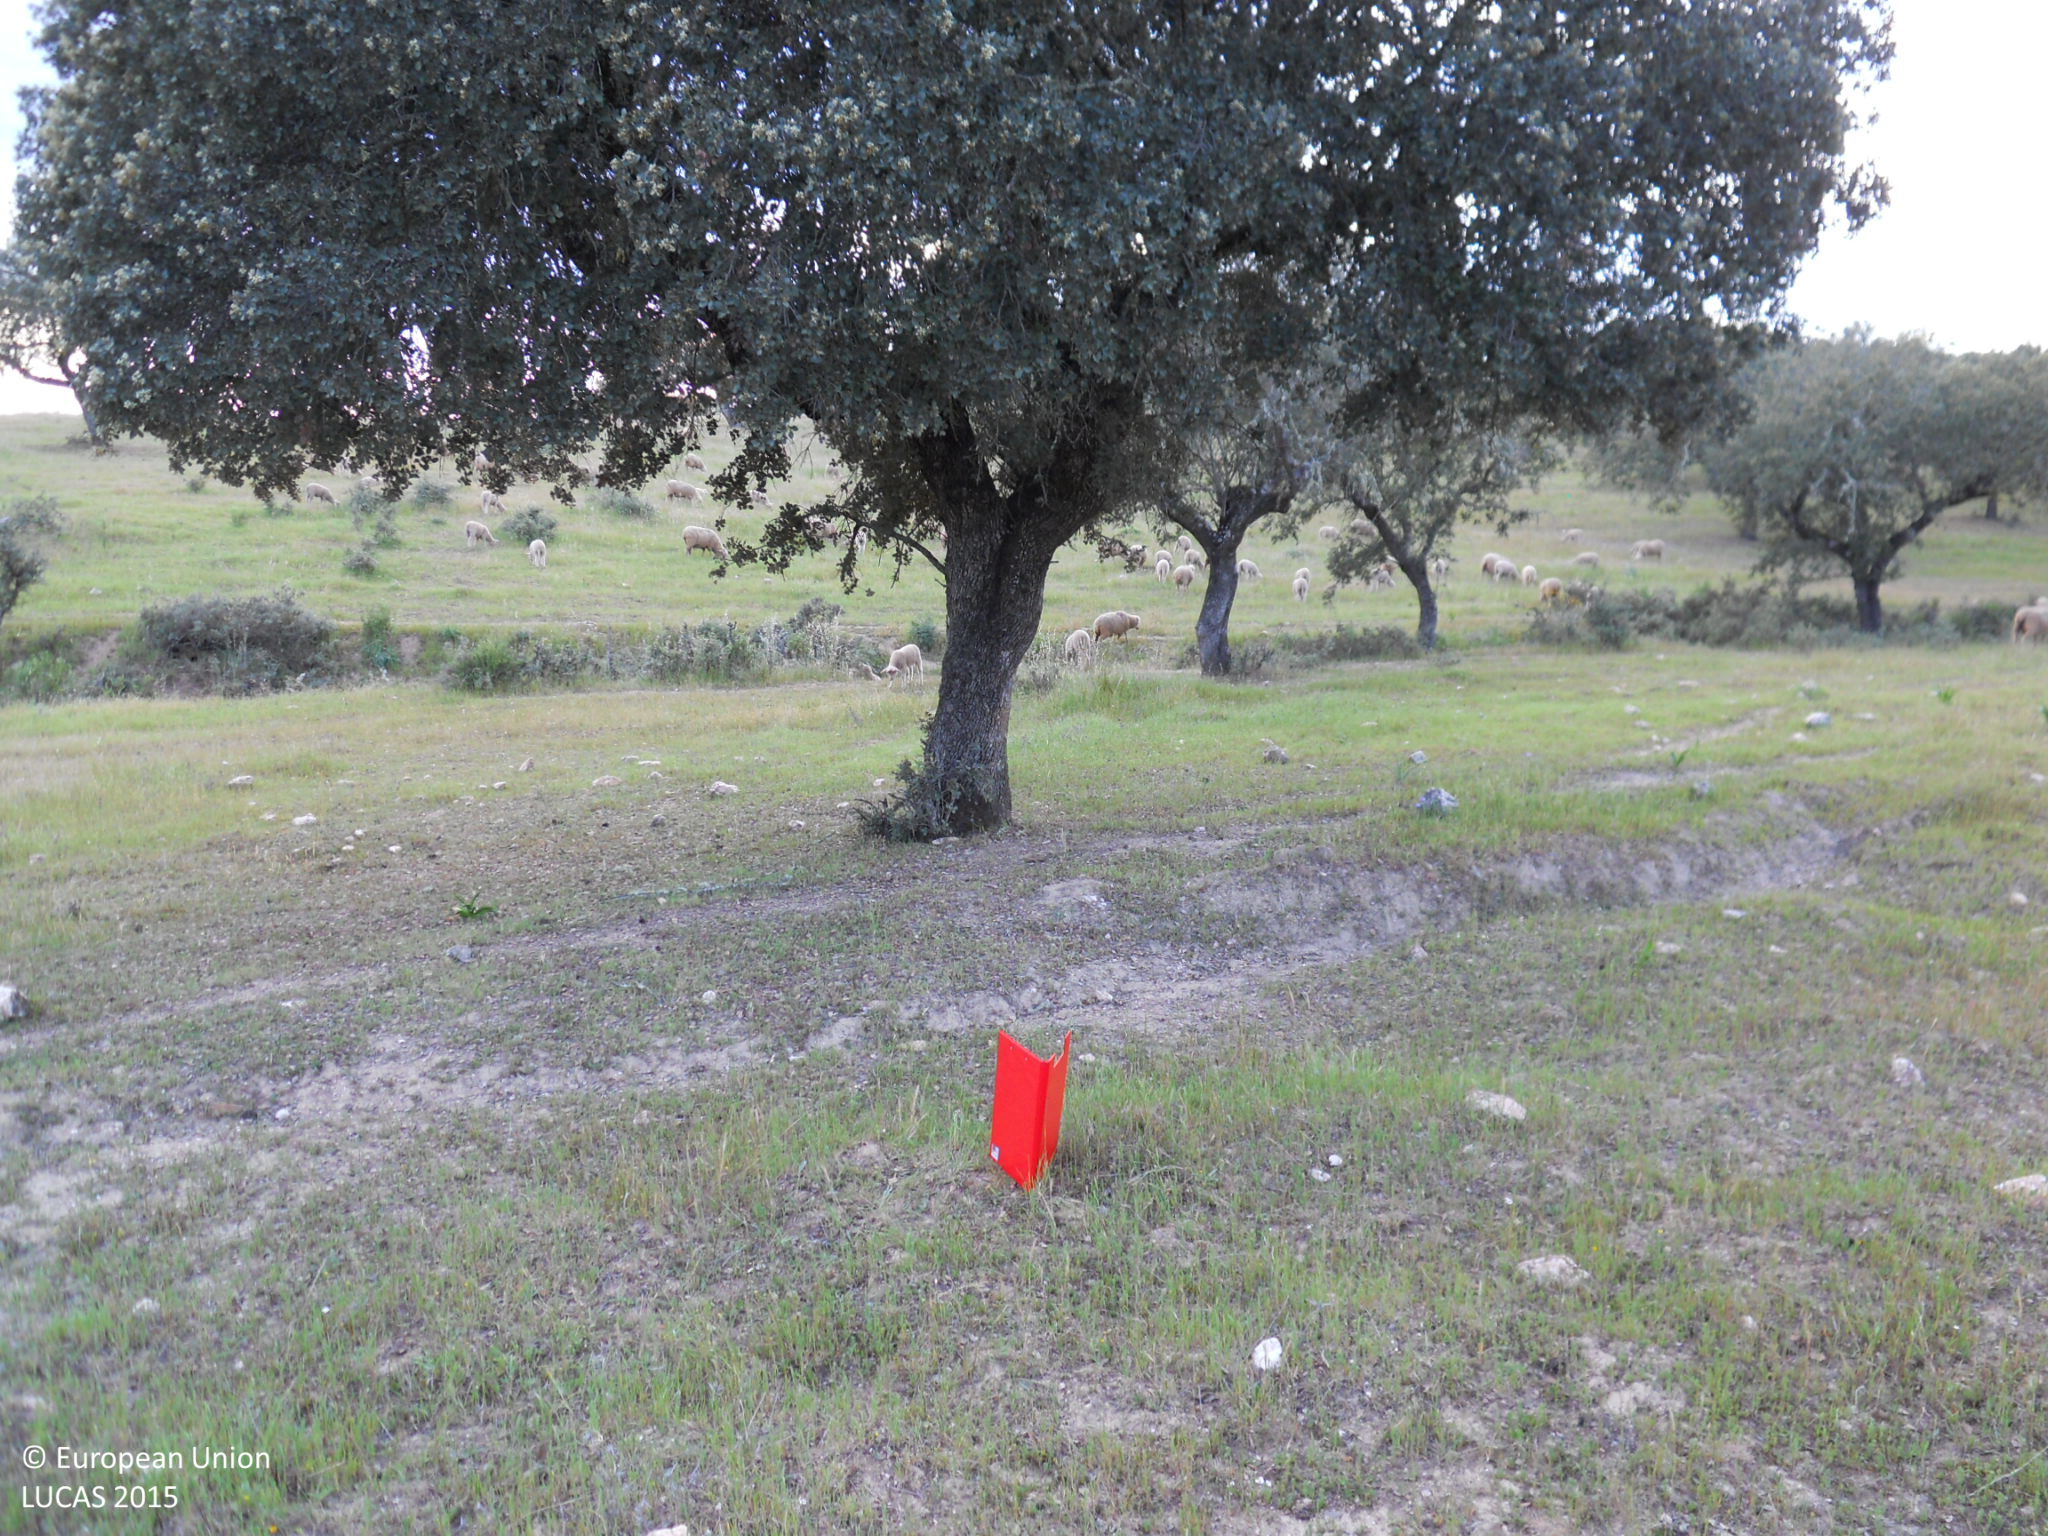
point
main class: Woodland
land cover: Broadleaved woodland
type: broadleaved evergreen forest
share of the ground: > 75 %
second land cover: Grassland without tree/shrub cover
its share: > 75 %
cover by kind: broadleaved forest trees 95 %, herbaceous plants 5 %
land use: Forestry
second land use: Agriculture (excluding fallow land and kitchen gardens)
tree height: > 5 m
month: April
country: ES
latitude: 39.2329
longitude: -6.7892
